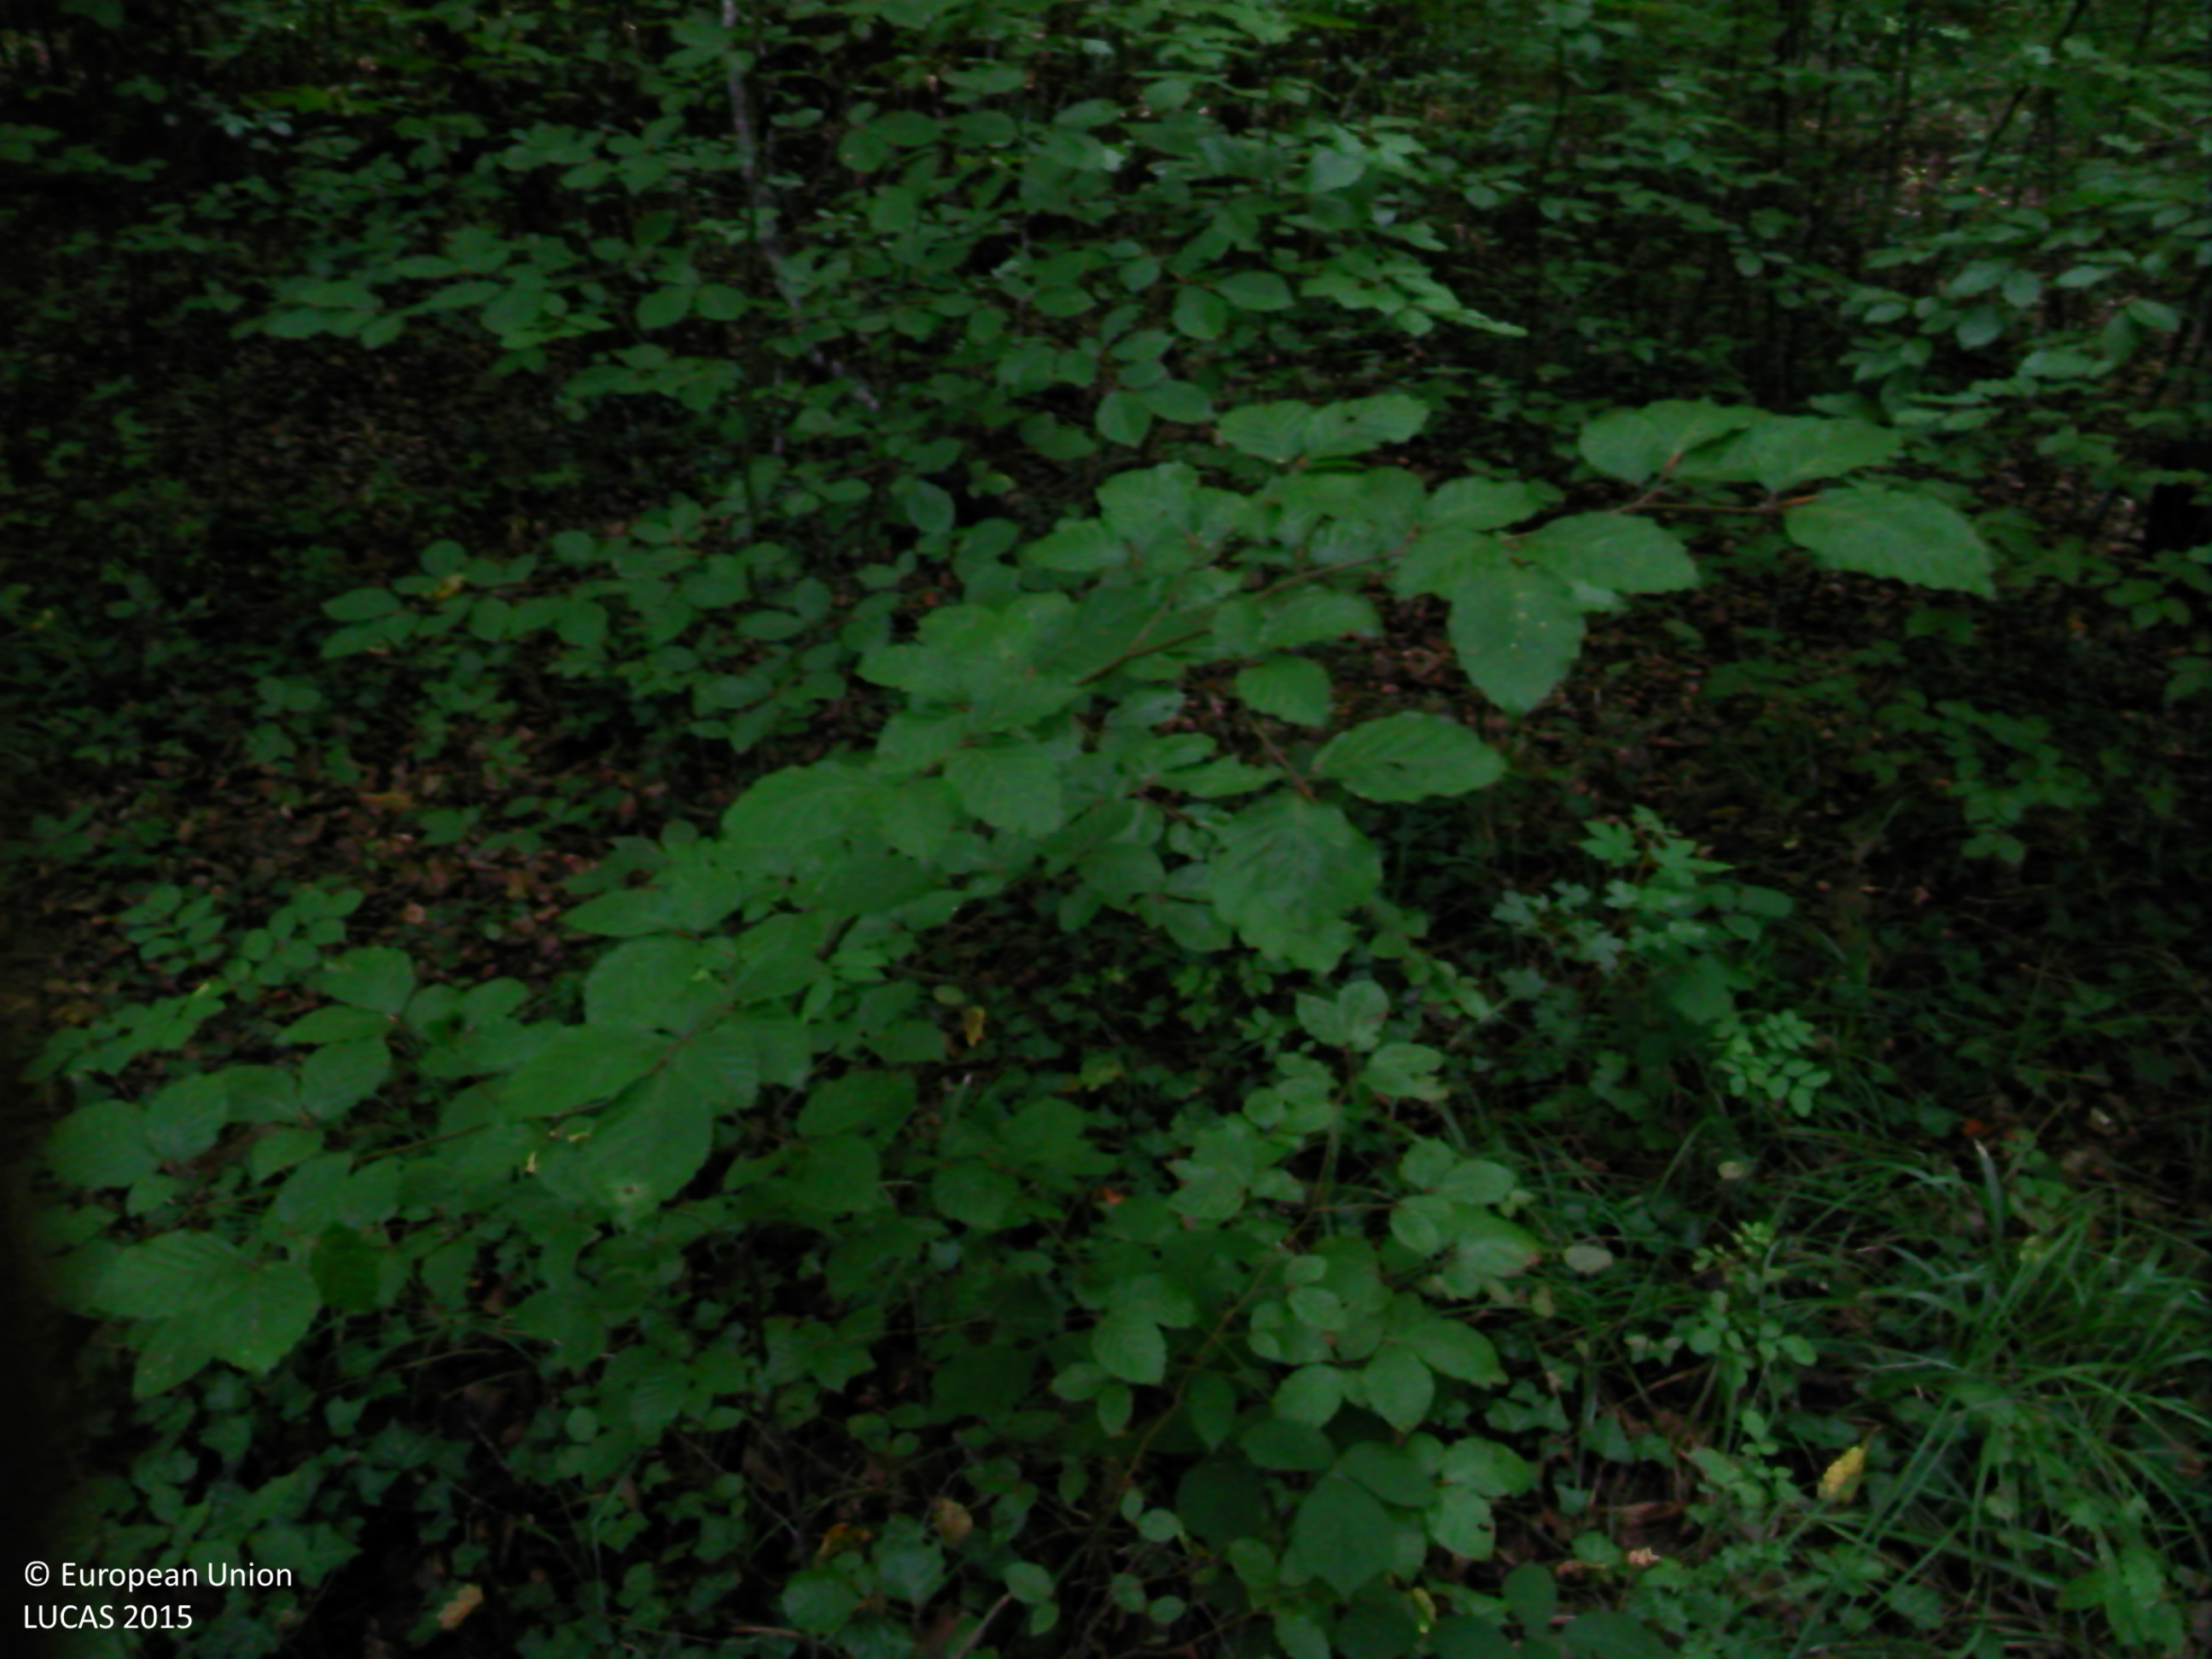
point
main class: Woodland
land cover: Broadleaved woodland
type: beech forest
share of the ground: > 75 %
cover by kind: broadleaved forest trees 85 %, herbaceous plants 10 %, shrubs 5 %
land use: Forestry
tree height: > 5 m
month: September
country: FR
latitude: 48.1919
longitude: 4.8193
